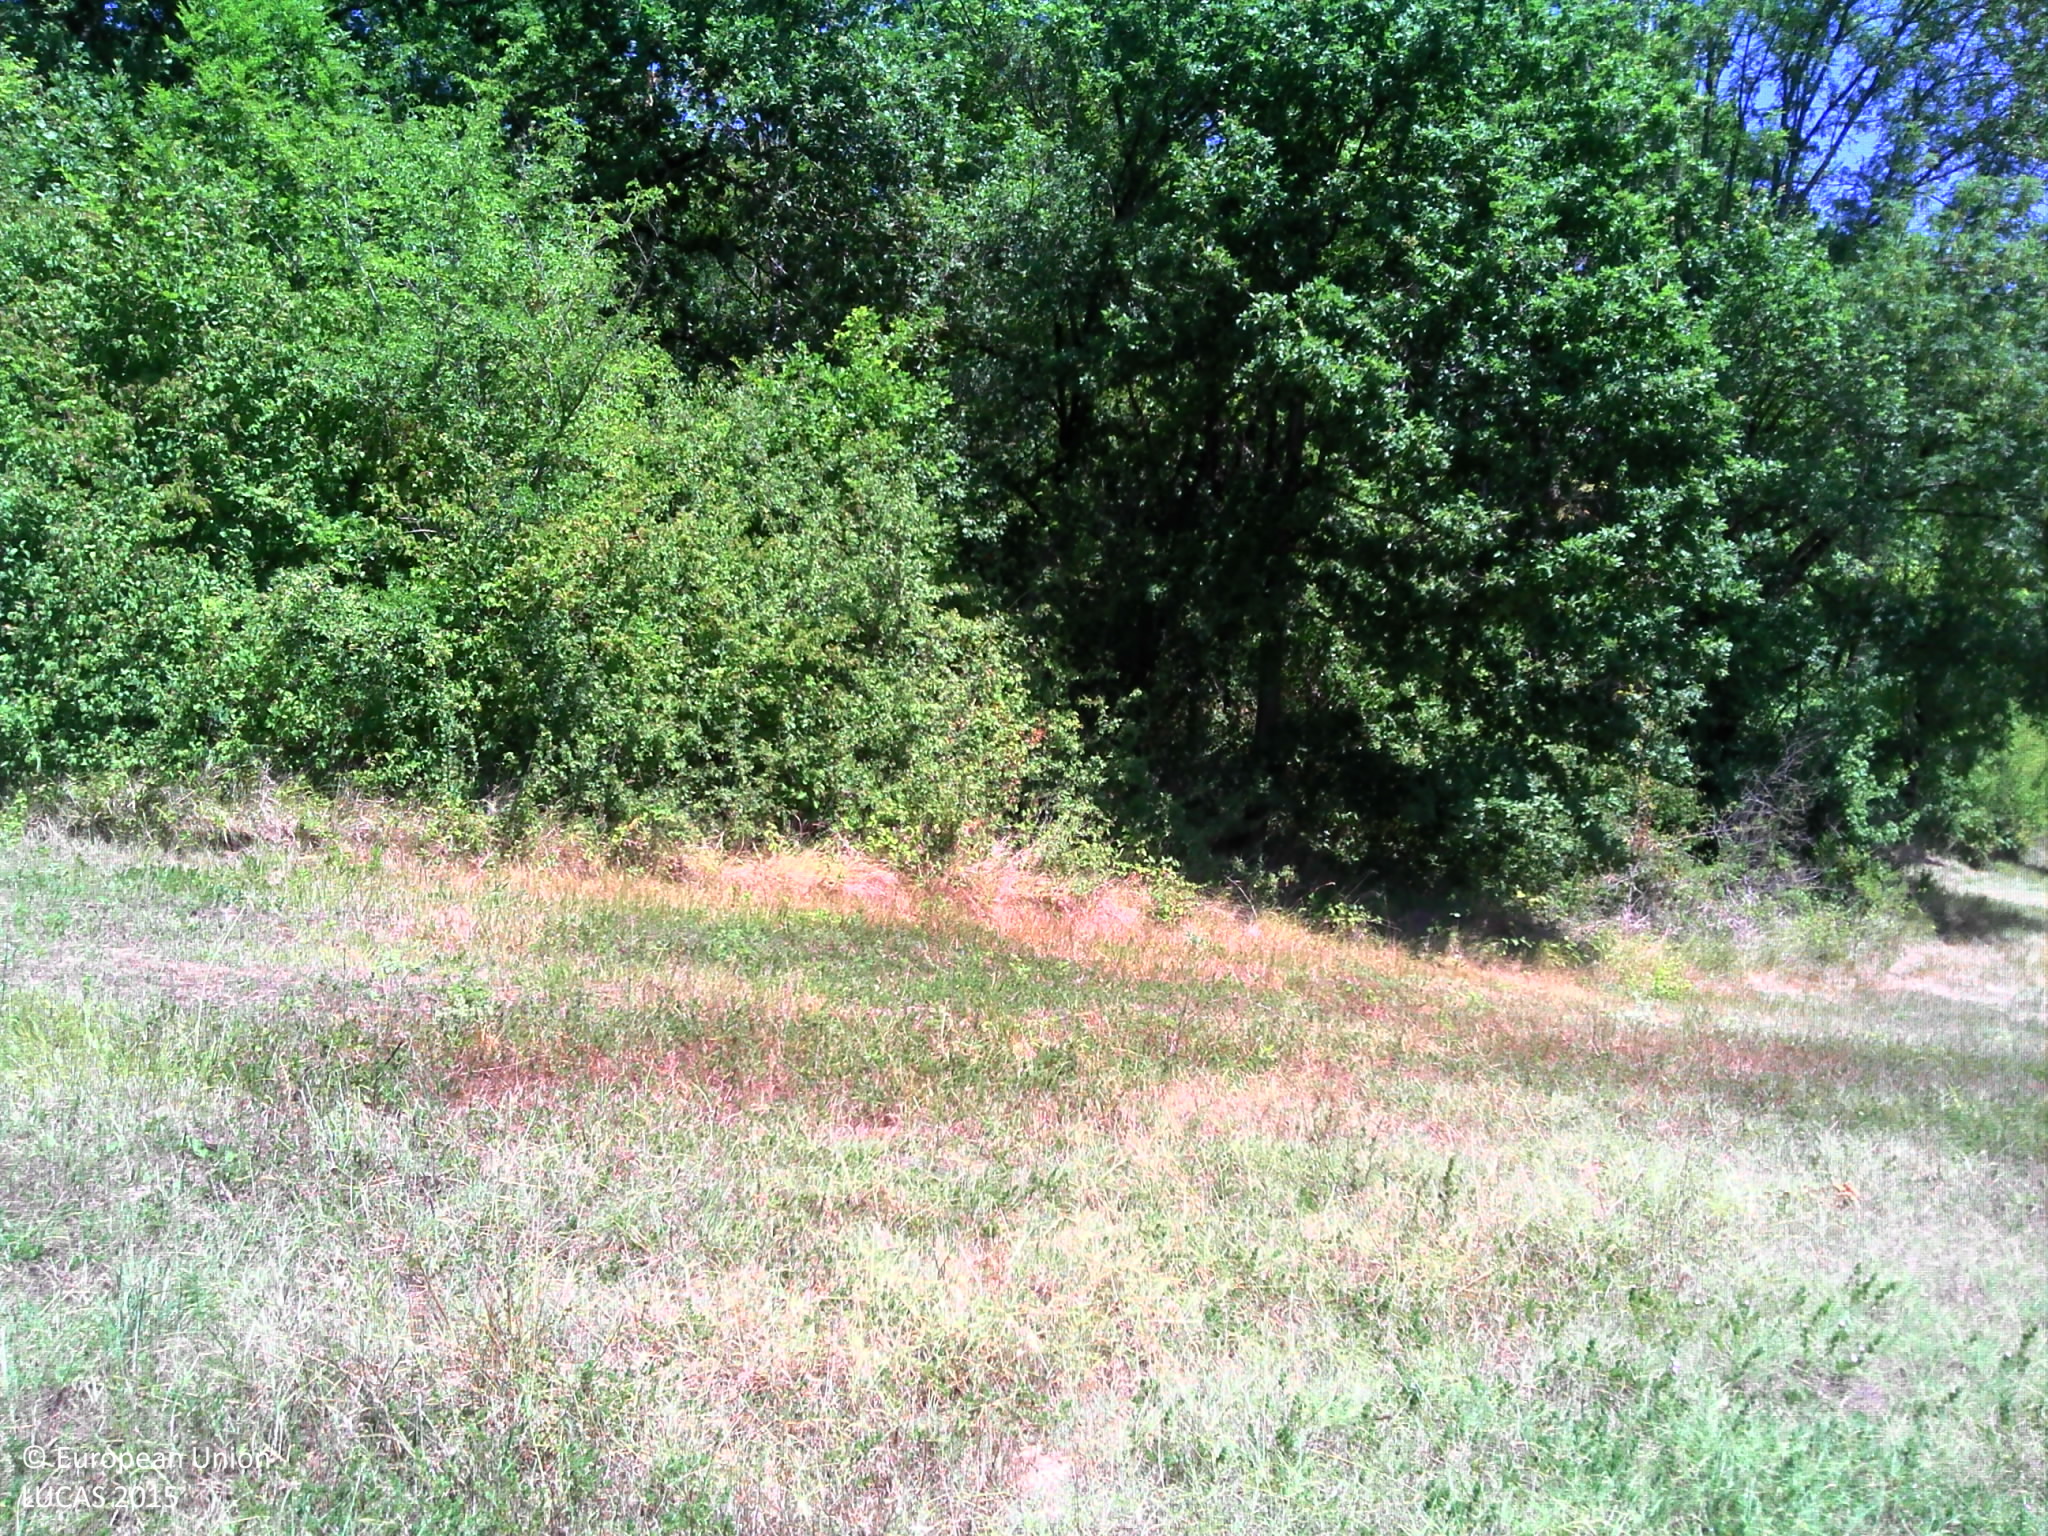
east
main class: Grassland
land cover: Grassland without tree/shrub cover
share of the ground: > 75 %
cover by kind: herbaceous plants 100 %
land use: Agriculture (excluding fallow land and kitchen gardens)
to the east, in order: Grassland without tree/shrub cover; Broadleaved woodland; Tracks; Broadleaved woodland; Fences; Rock outcrops; Broadleaved woodland; Fences; Grassland without tree/shrub cover; Fences; Broadleaved woodland
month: July
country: FR
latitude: 44.6152
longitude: 0.6293
